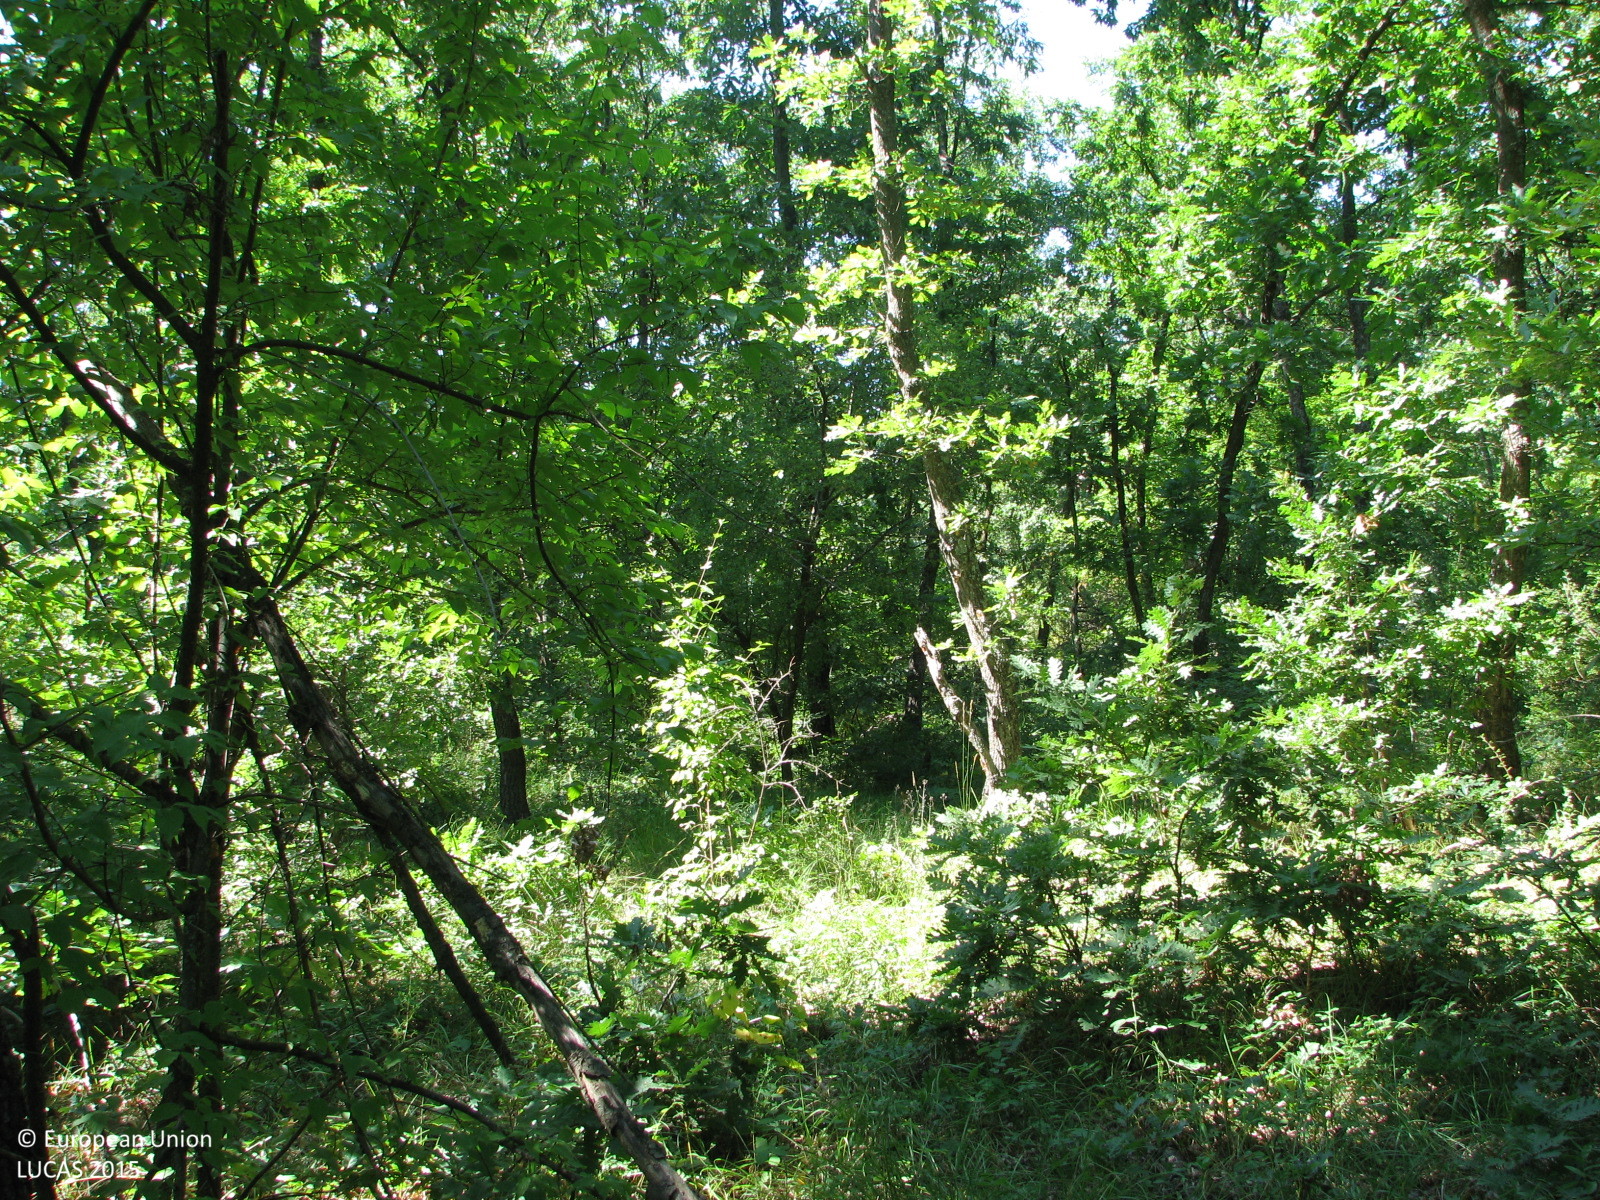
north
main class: Woodland
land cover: Broadleaved woodland
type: thermophilous deciduous forest
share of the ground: 50 - 75 %
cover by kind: broadleaved forest trees 60 %, herbaceous plants 30 %, shrubs 10 %
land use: Forestry
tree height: > 5 m
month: July
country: BG
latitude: 42.2631
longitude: 26.8391
